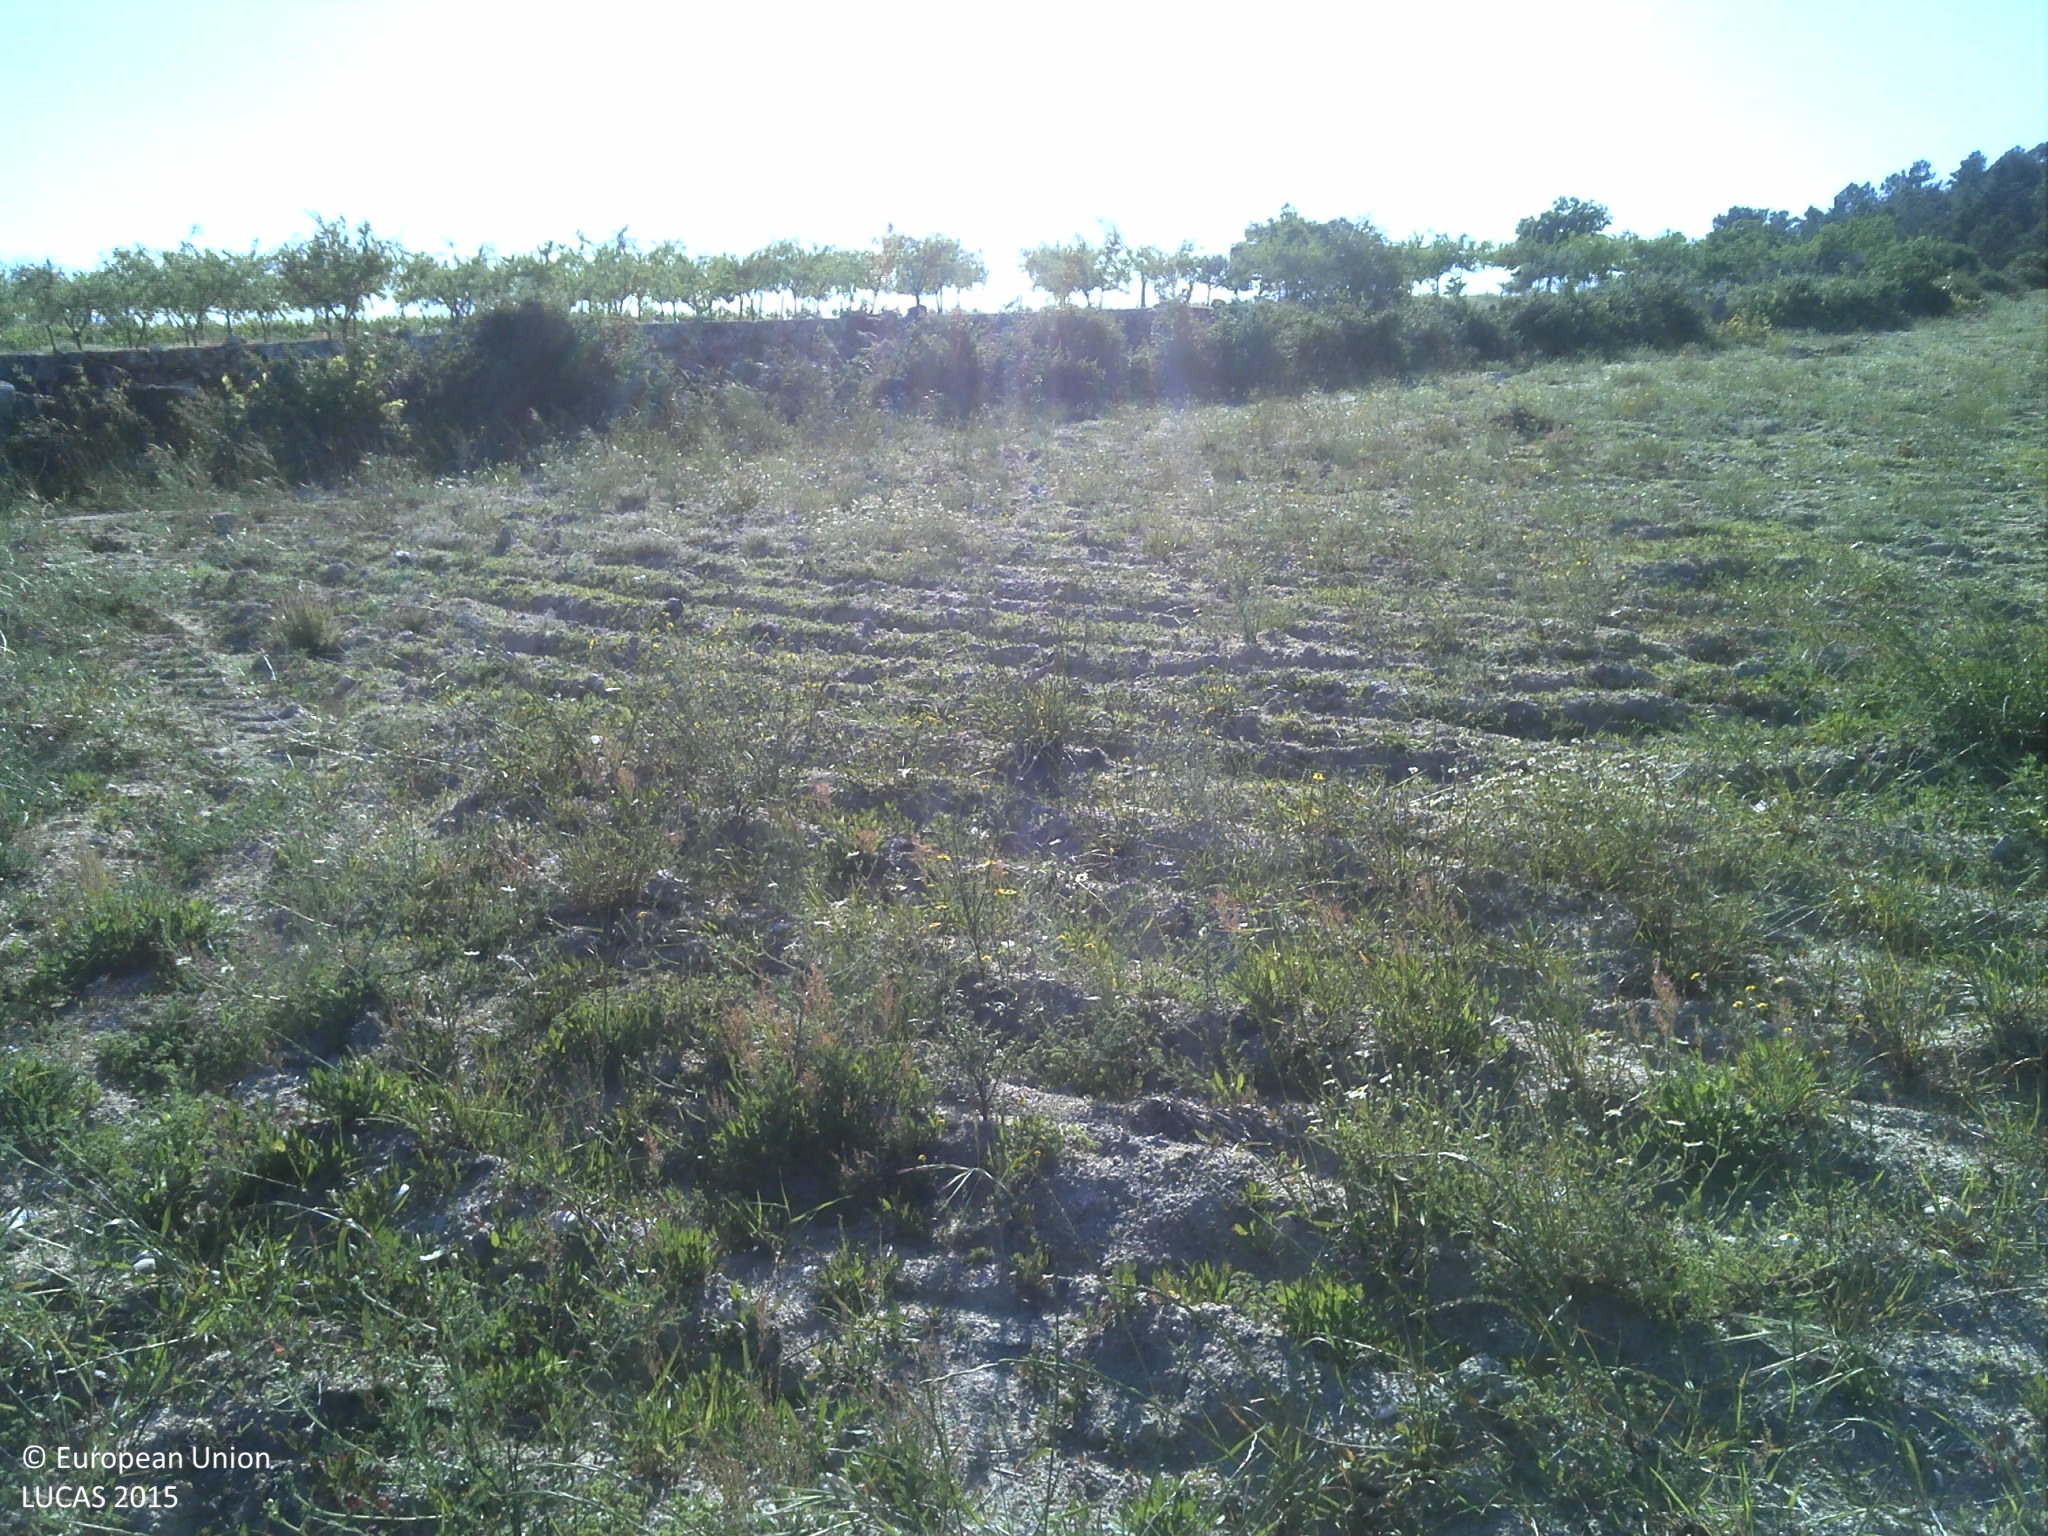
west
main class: Cropland
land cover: Olive groves
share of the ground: 10 - 25 %
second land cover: Grassland without tree/shrub cover
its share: 25 - 50 %
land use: Agriculture (excluding fallow land and kitchen gardens)
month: May
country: PT
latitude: 41.6309
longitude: -7.3014
